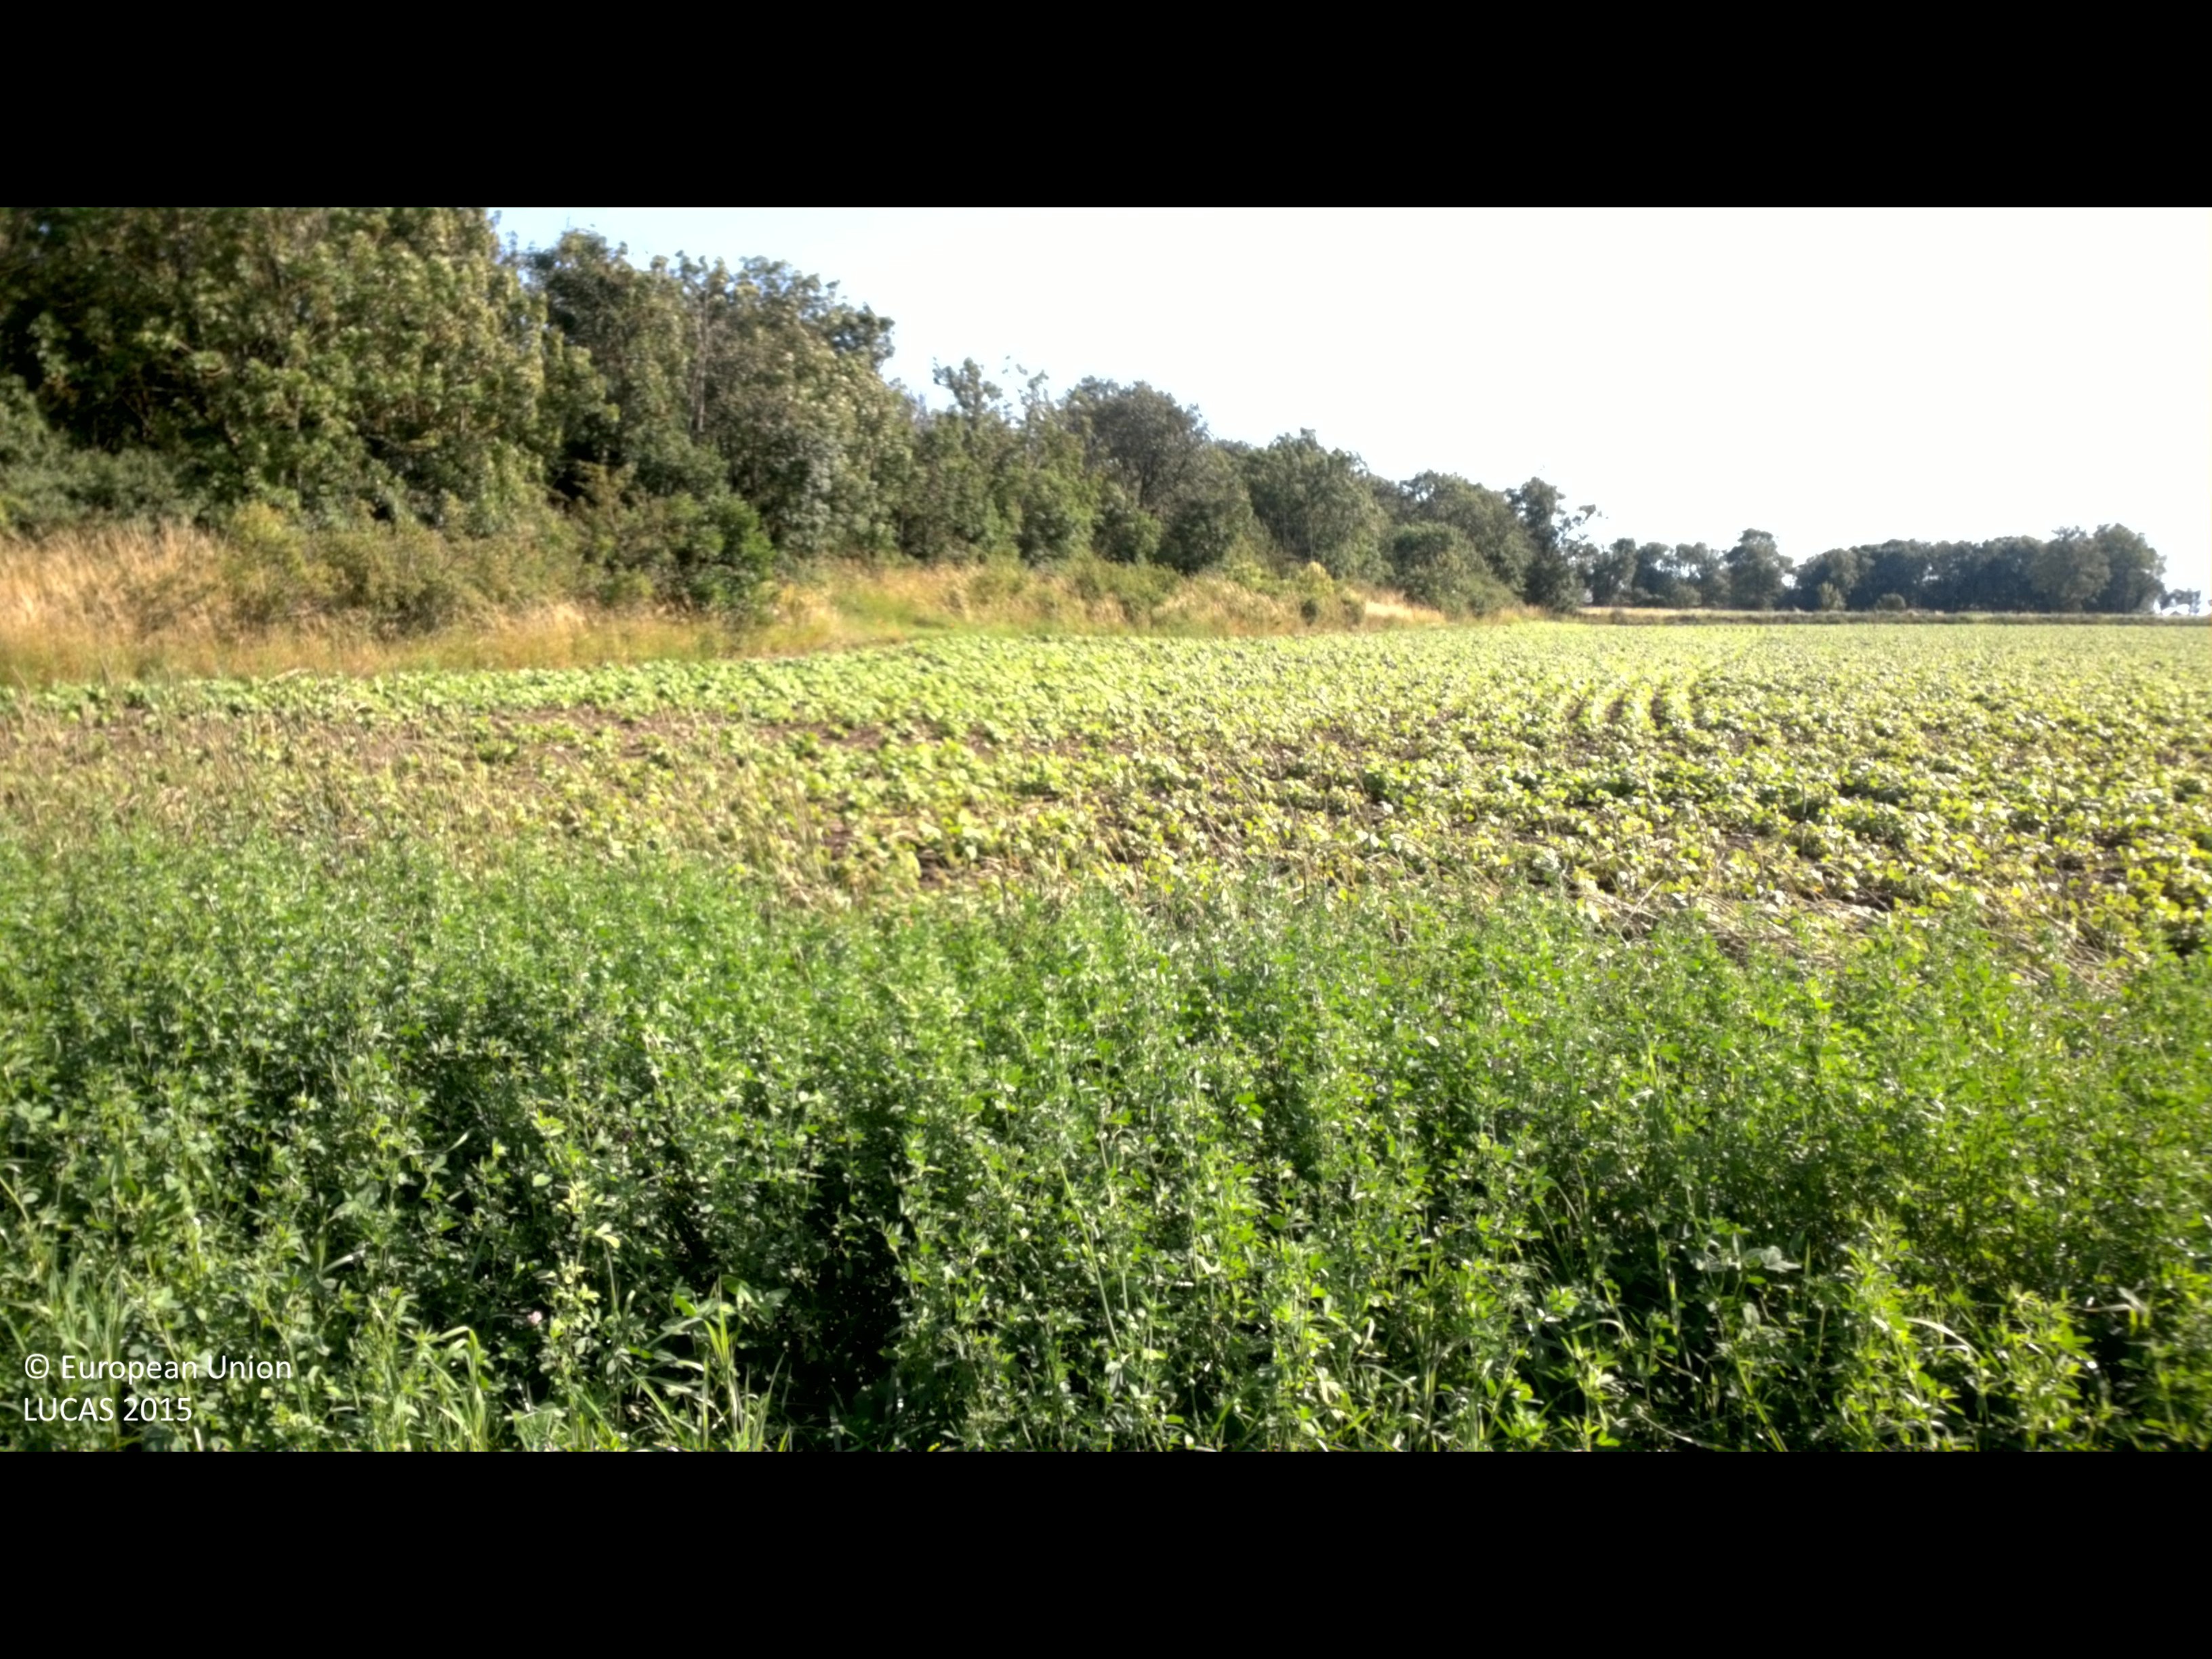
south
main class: Cropland
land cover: Lucerne
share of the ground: > 75 %
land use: Agriculture (excluding fallow land and kitchen gardens)
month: July
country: SE
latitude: 56.3873
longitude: 16.4321
